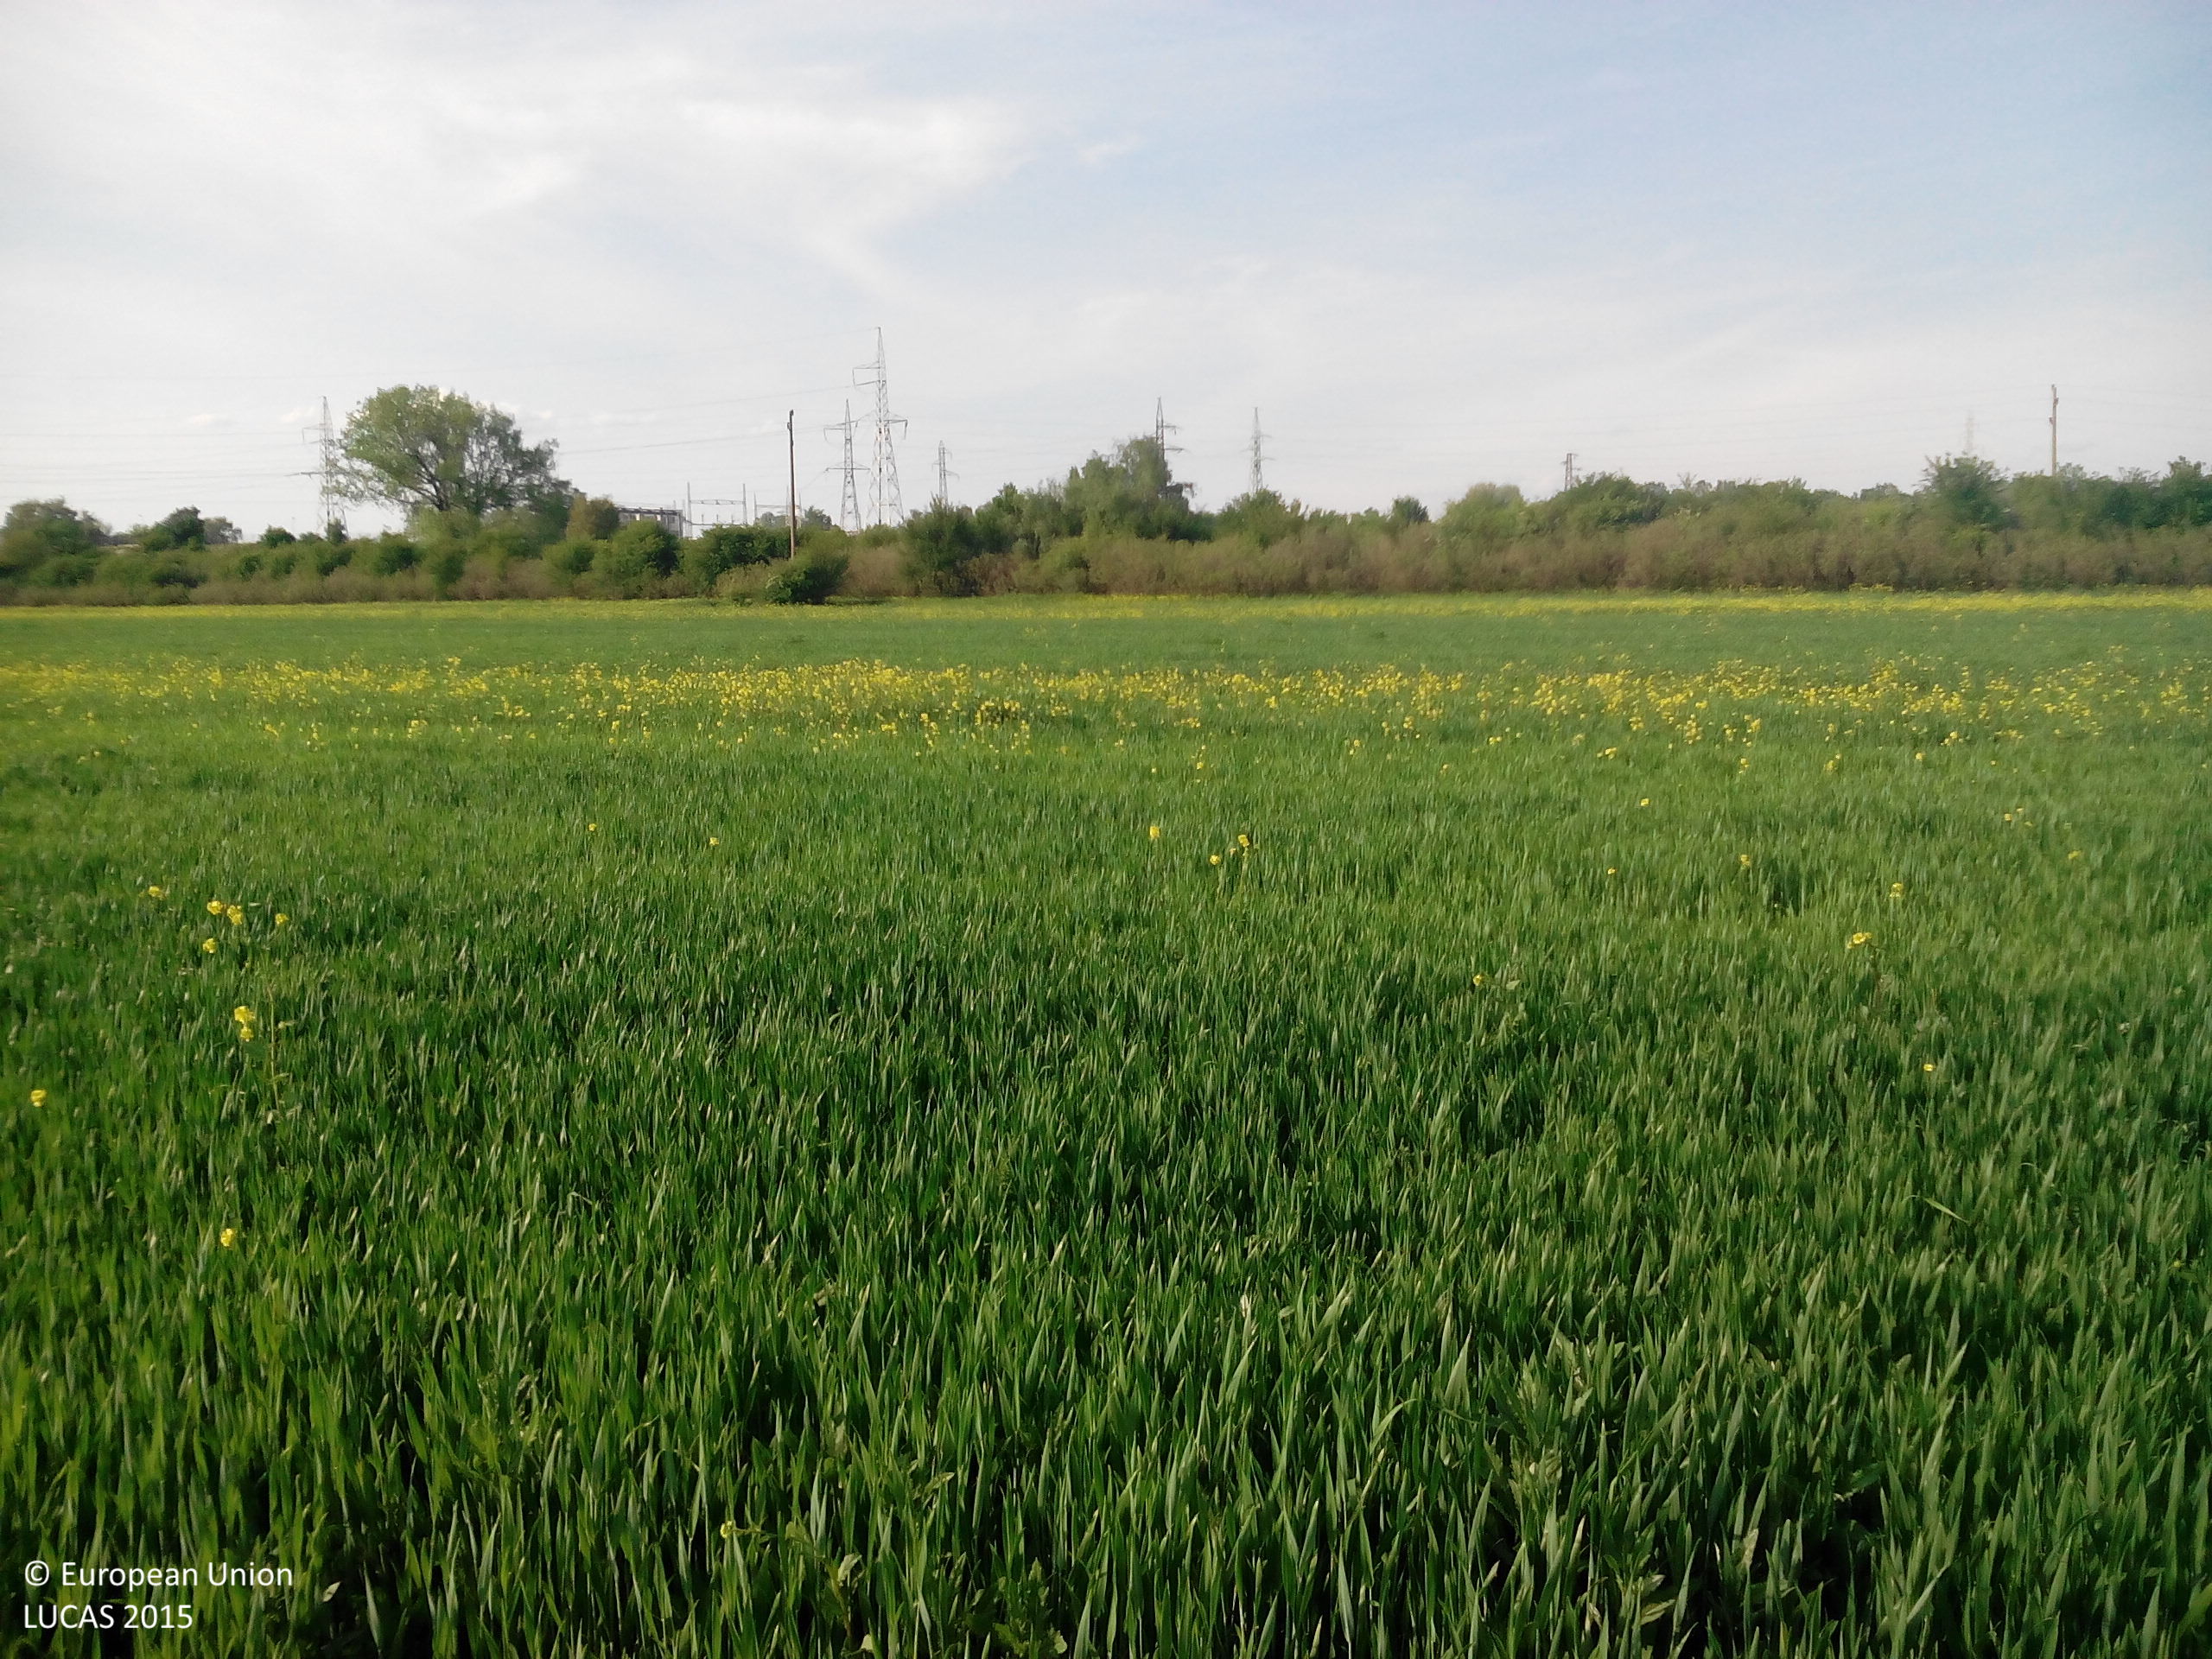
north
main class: Cropland
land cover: Common wheat
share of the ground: > 75 %
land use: Agriculture (excluding fallow land and kitchen gardens)
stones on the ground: < 10 %
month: May
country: BG
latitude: 43.7458
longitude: 23.8489
